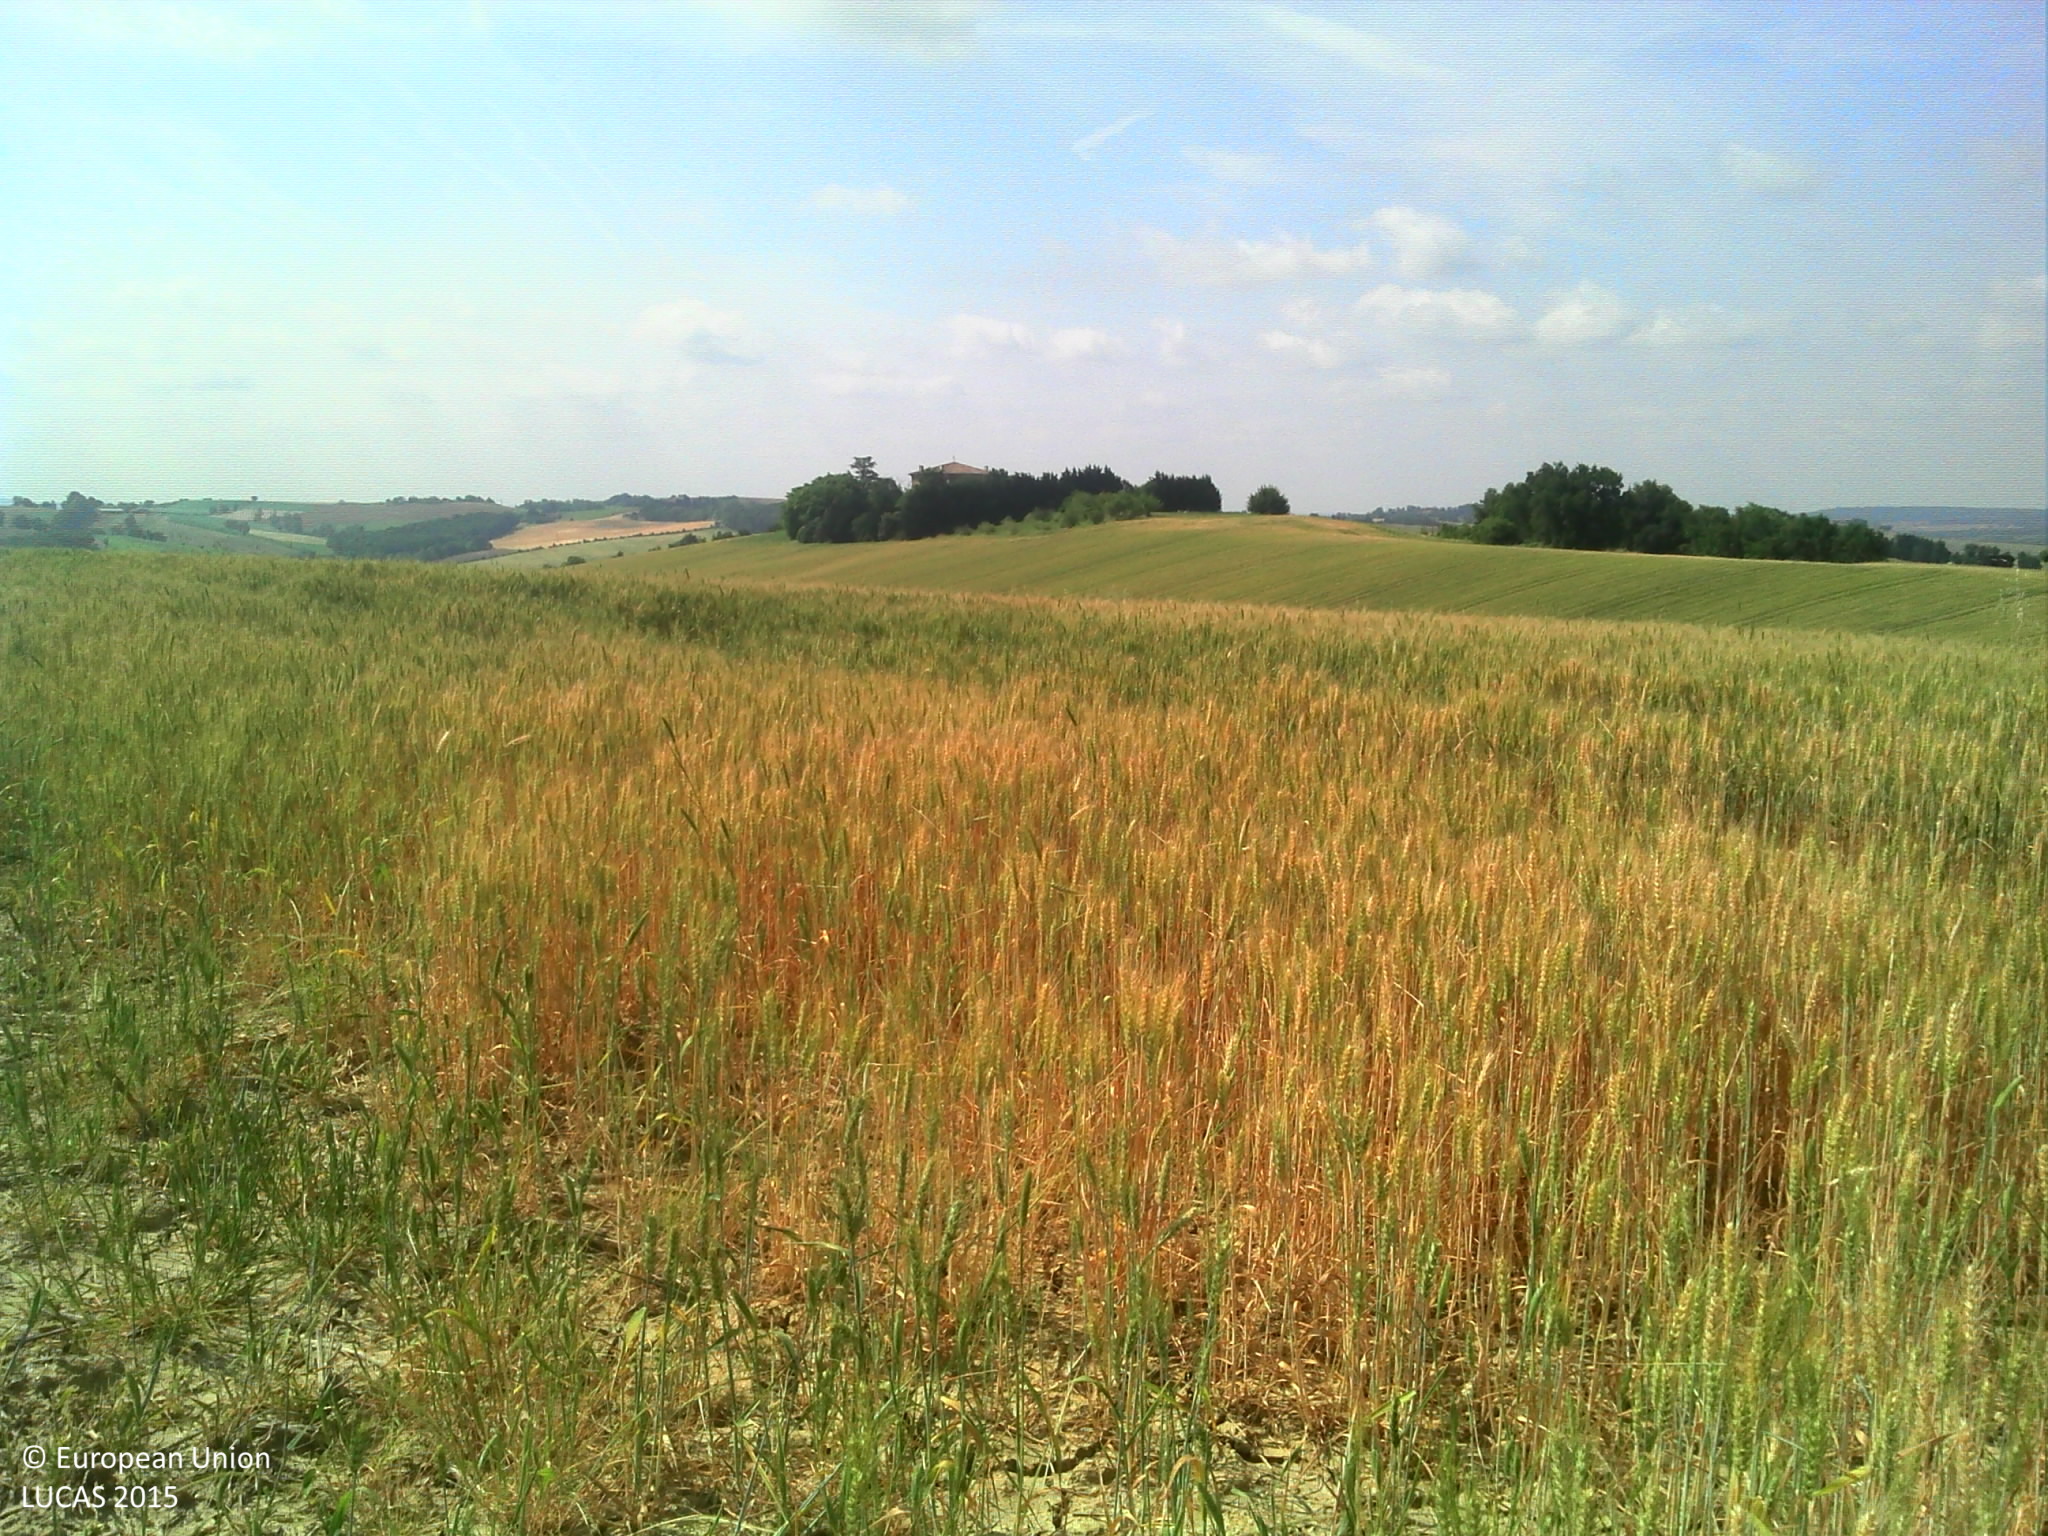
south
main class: Cropland
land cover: Common wheat
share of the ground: 50 - 75 %
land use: Agriculture (excluding fallow land and kitchen gardens)
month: June
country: FR
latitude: 43.8728
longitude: 1.7020
